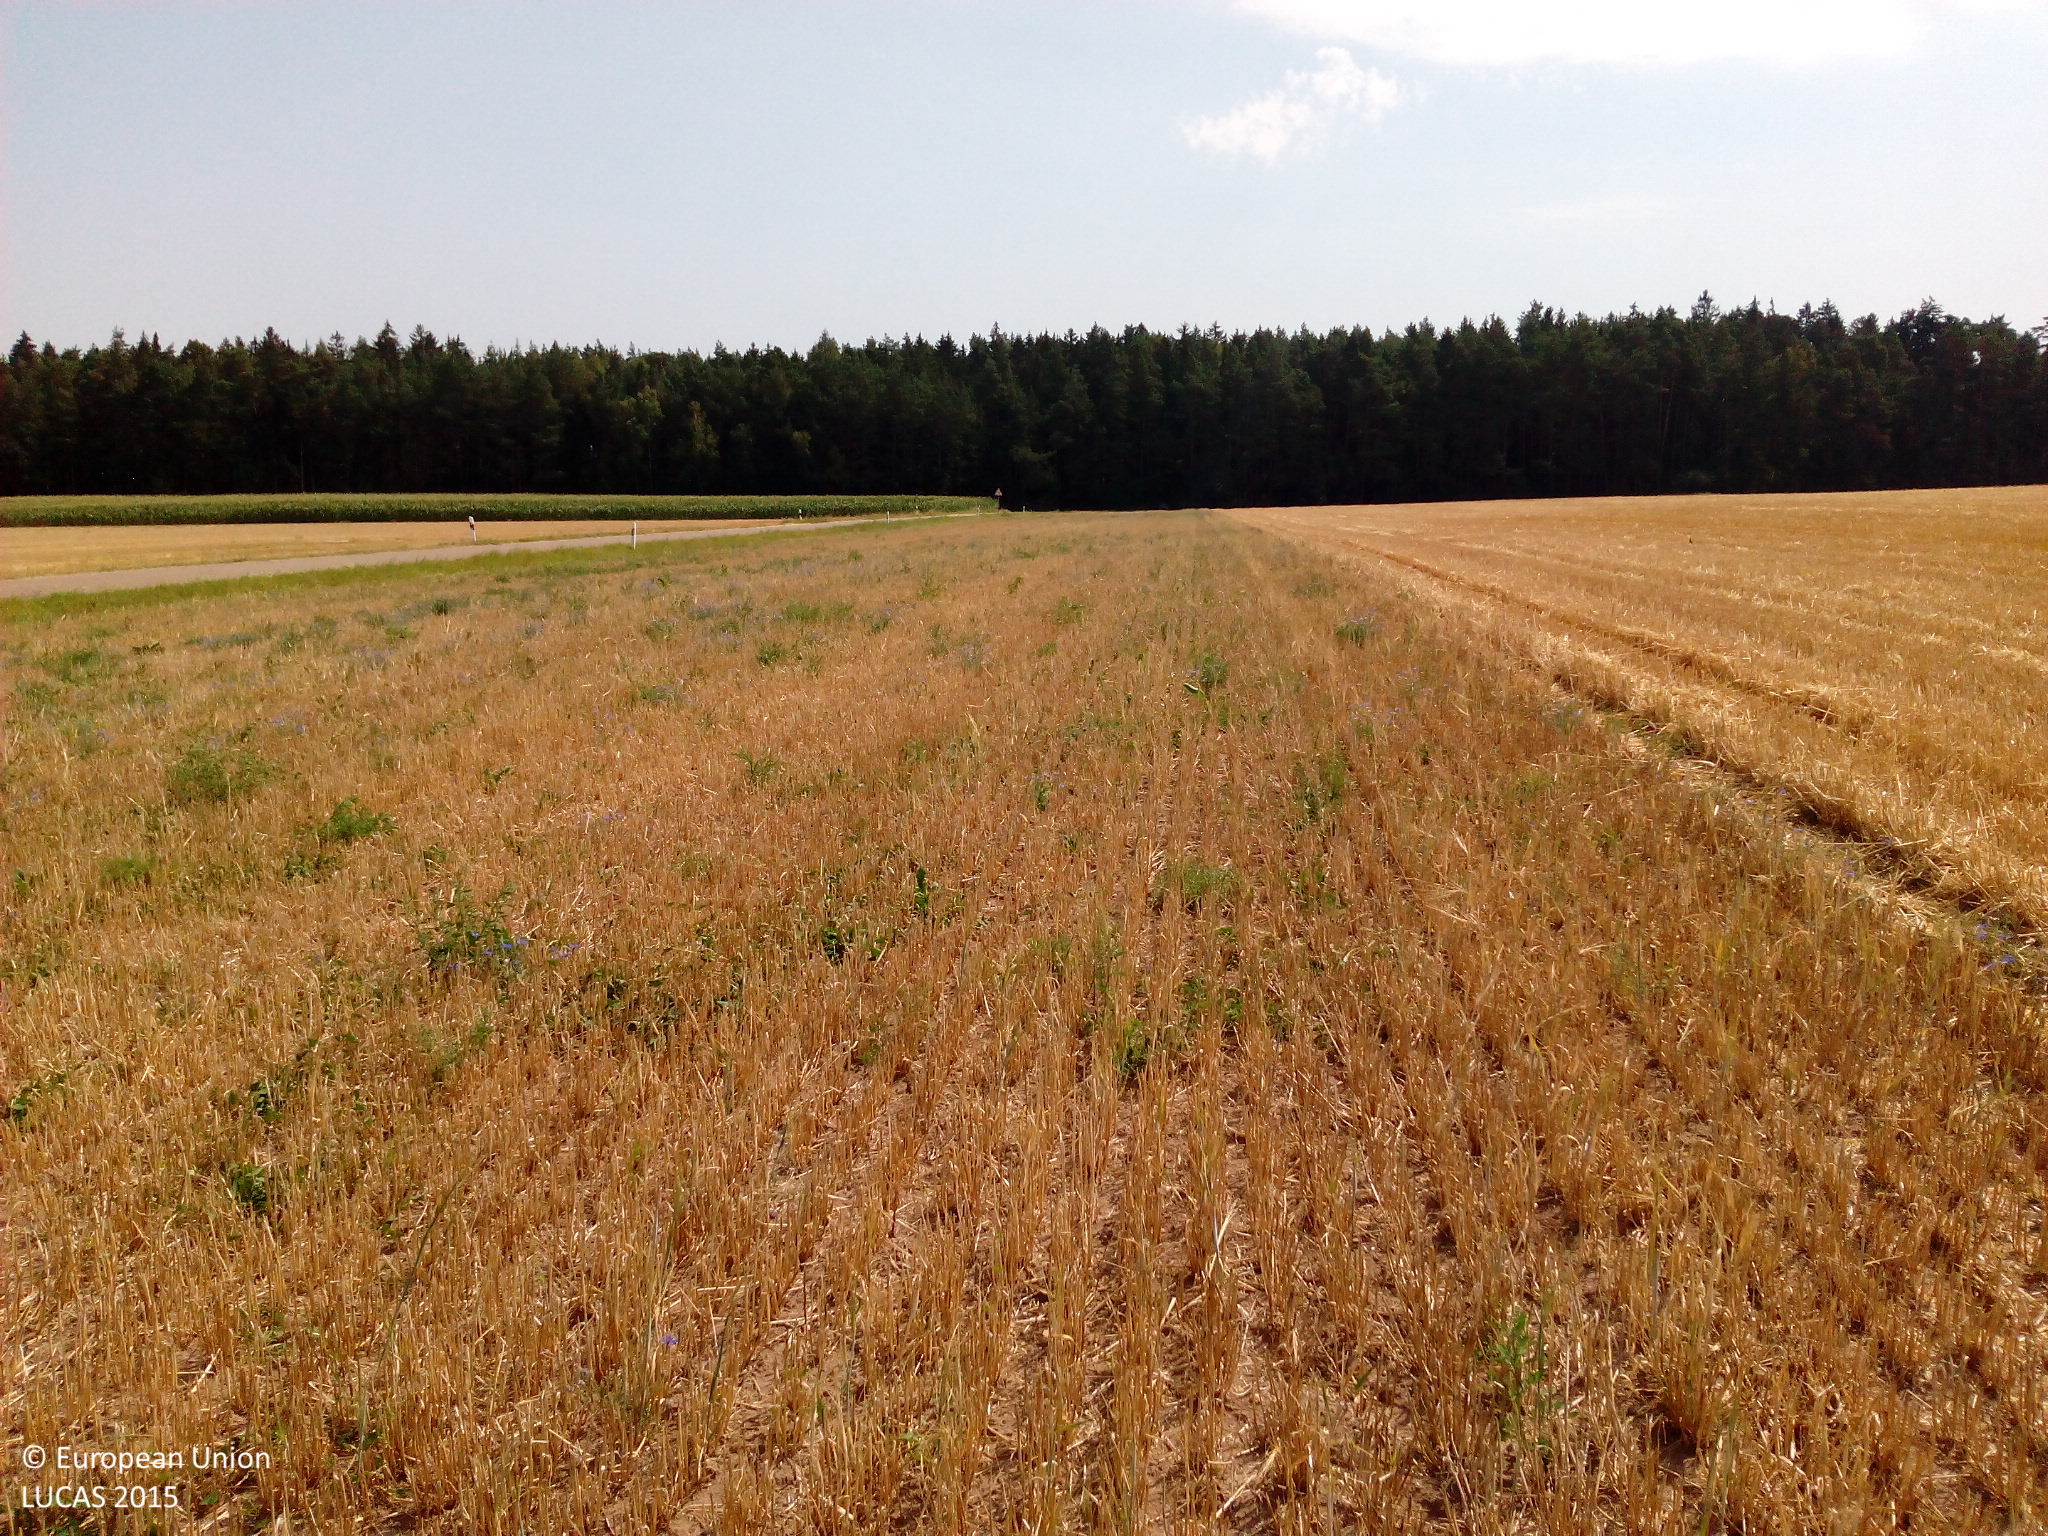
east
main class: Cropland
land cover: Barley
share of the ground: < 10 %
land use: Agriculture (excluding fallow land and kitchen gardens)
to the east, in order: Barley; Grass margins; Tracks
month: August
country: DE
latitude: 49.1048
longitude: 10.2601
